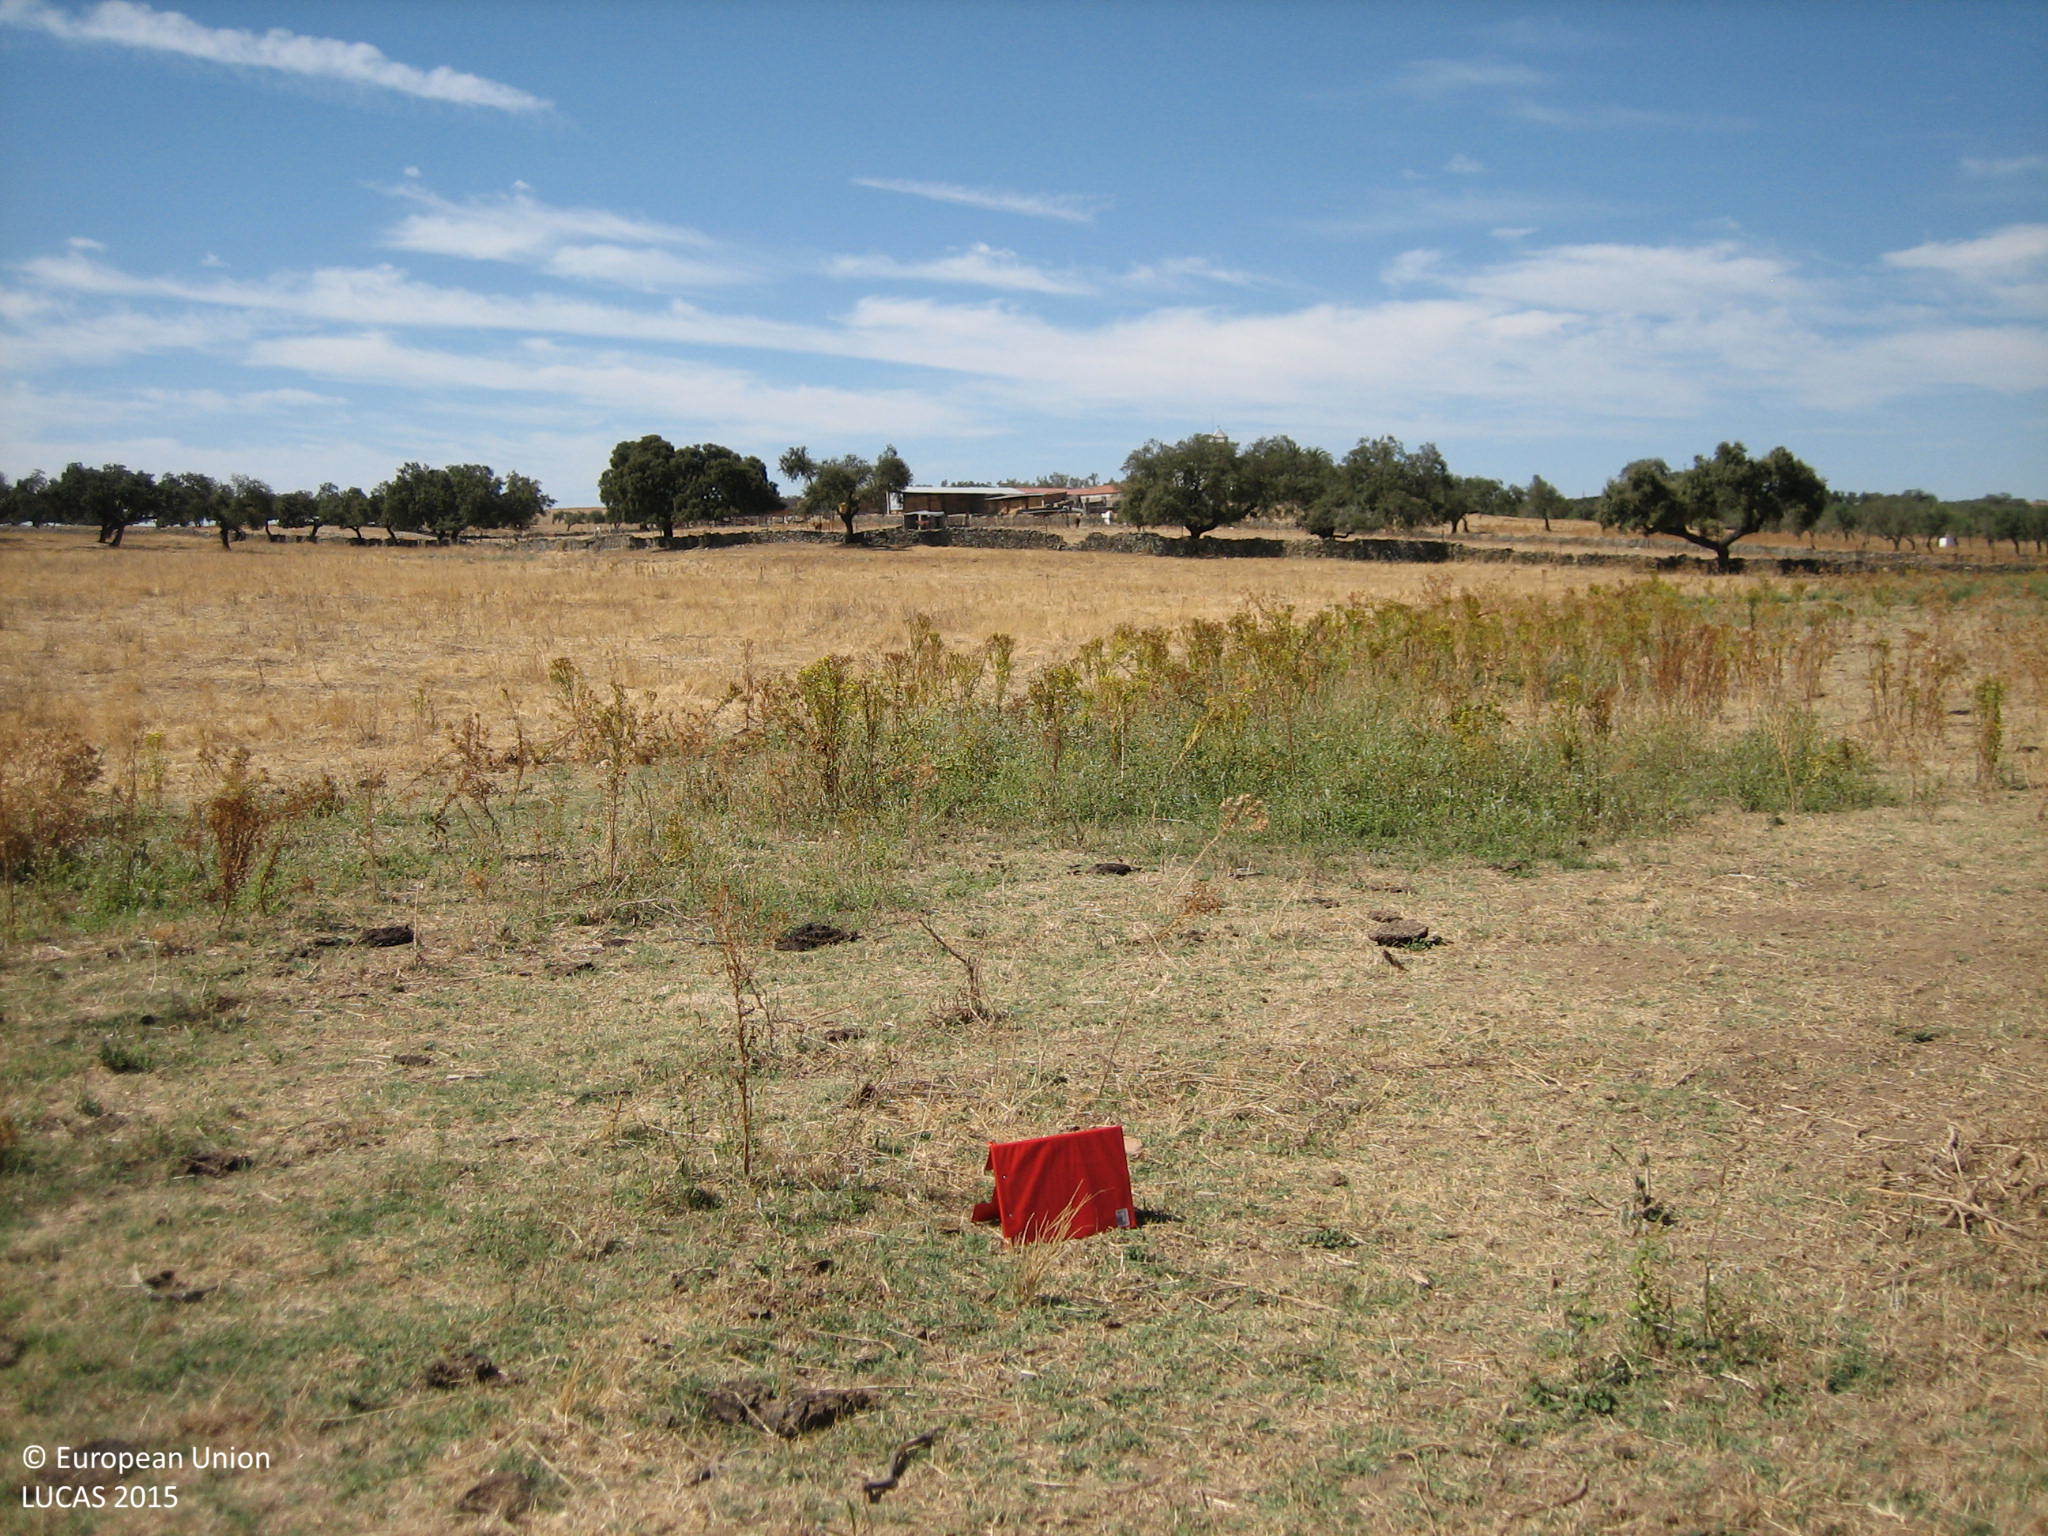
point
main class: Grassland
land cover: Grassland without tree/shrub cover
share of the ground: 50 - 75 %
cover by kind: herbaceous plants 70 %, unconsolidated bare surface 30 %
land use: Agriculture (excluding fallow land and kitchen gardens)
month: August
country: ES
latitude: 38.3529
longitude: -7.1718
